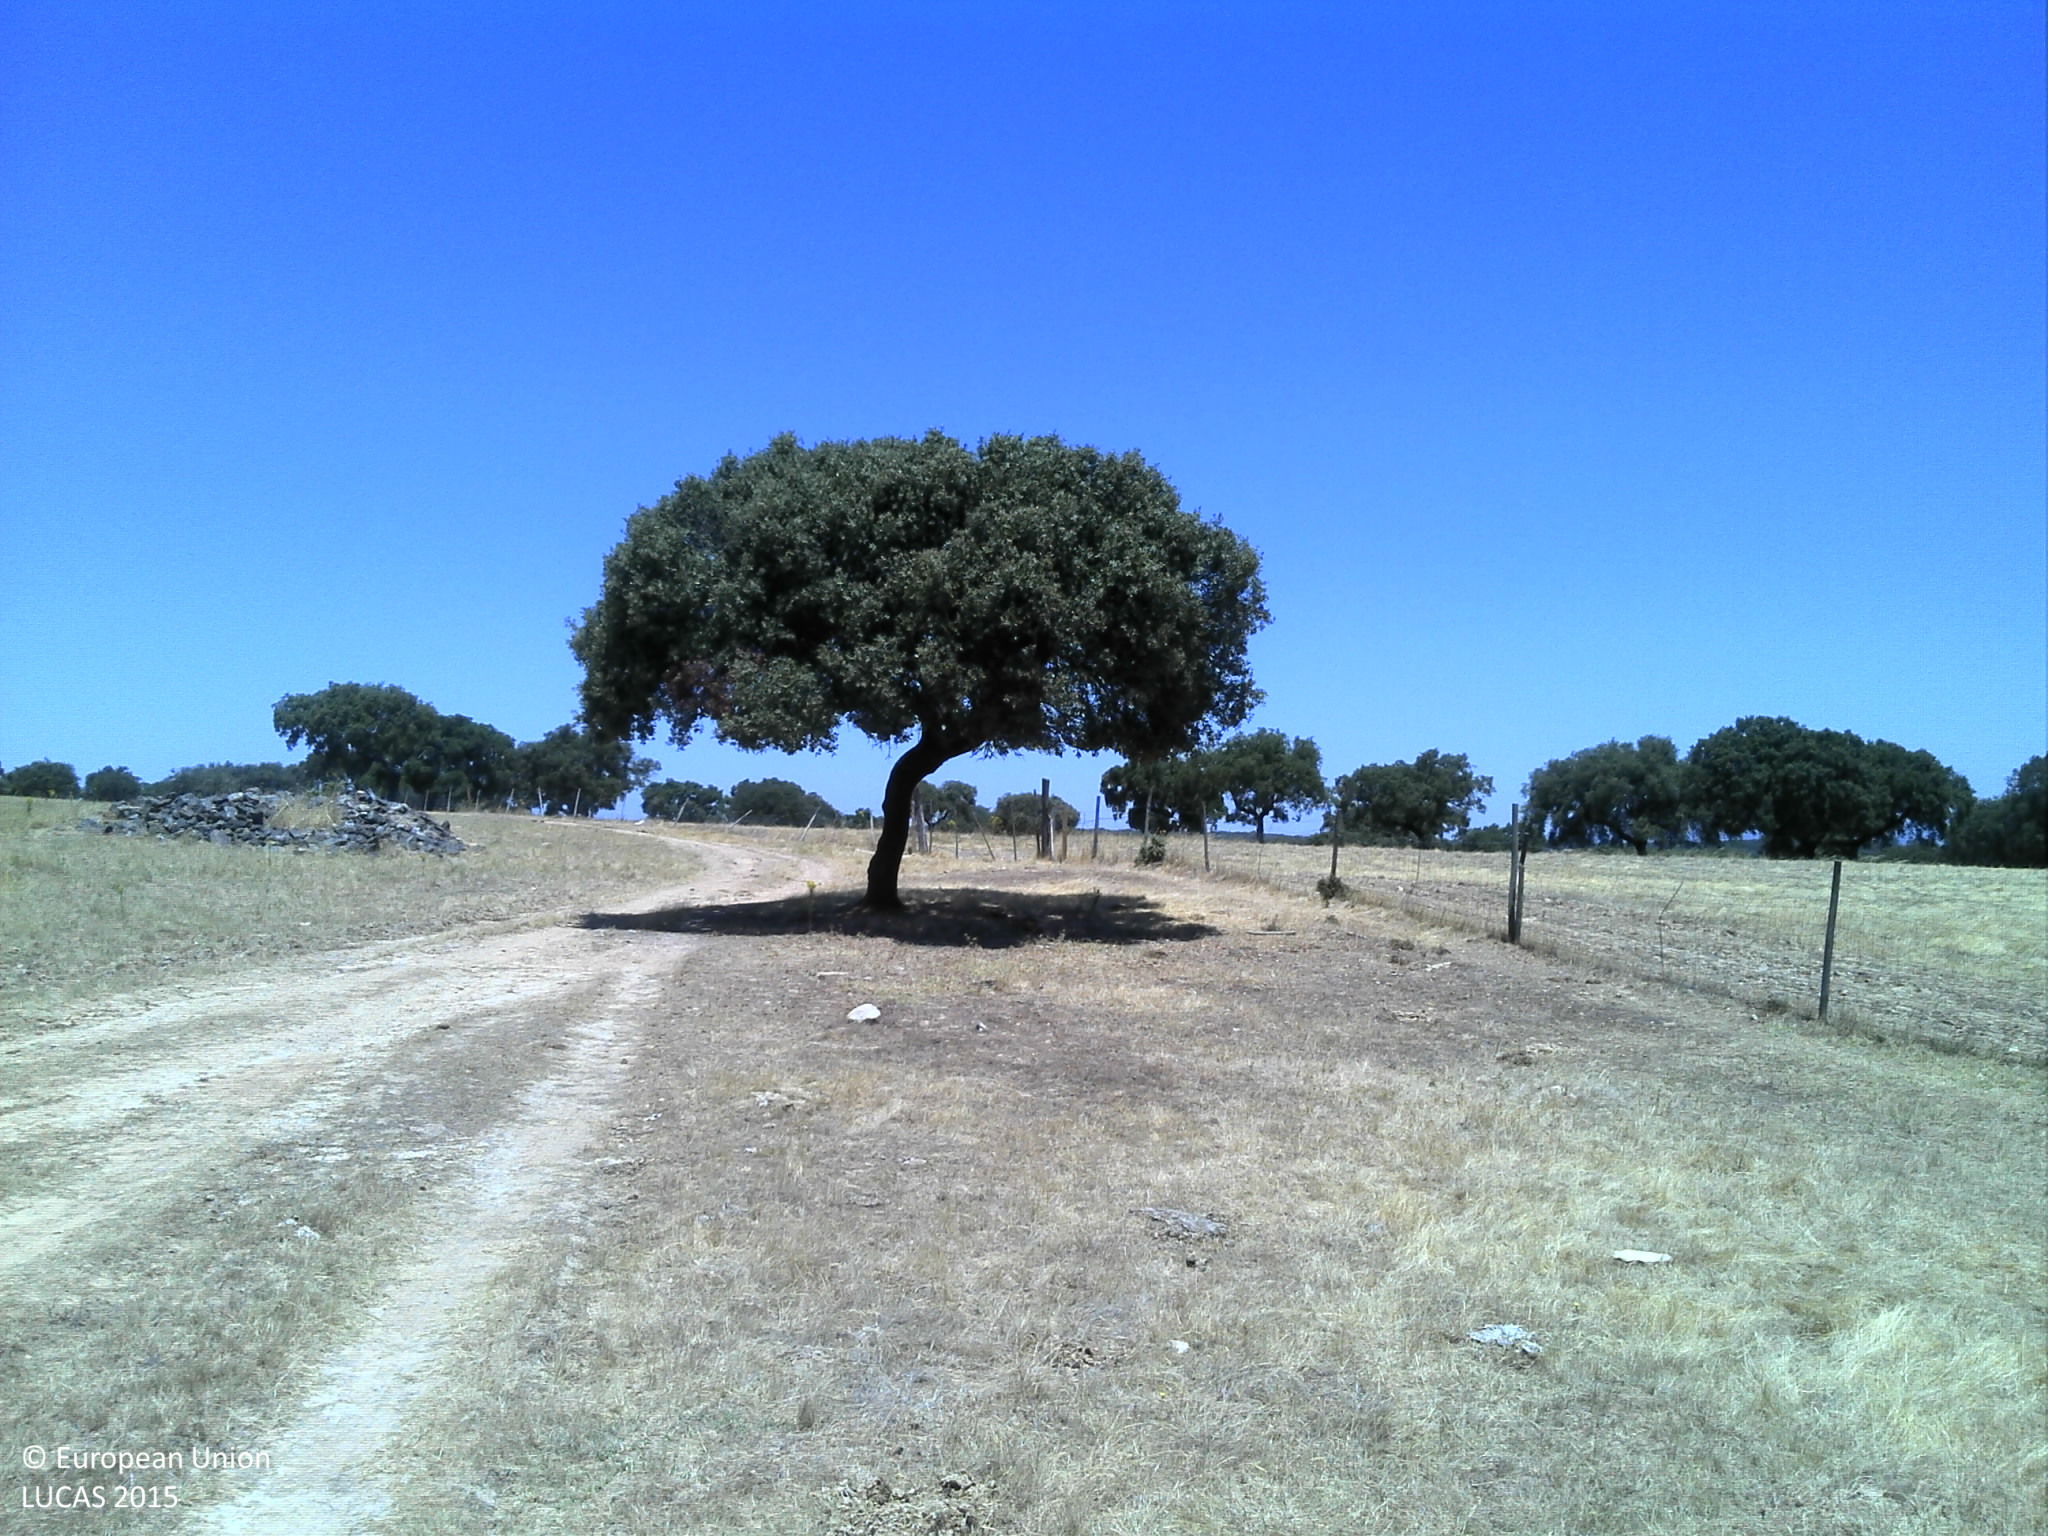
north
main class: Grassland
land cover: Grassland without tree/shrub cover
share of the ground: 25 - 50 %
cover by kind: unconsolidated bare surface 70 %, herbaceous plants 30 %
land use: Agriculture (excluding fallow land and kitchen gardens)
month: July
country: PT
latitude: 39.1382
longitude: -7.5219
